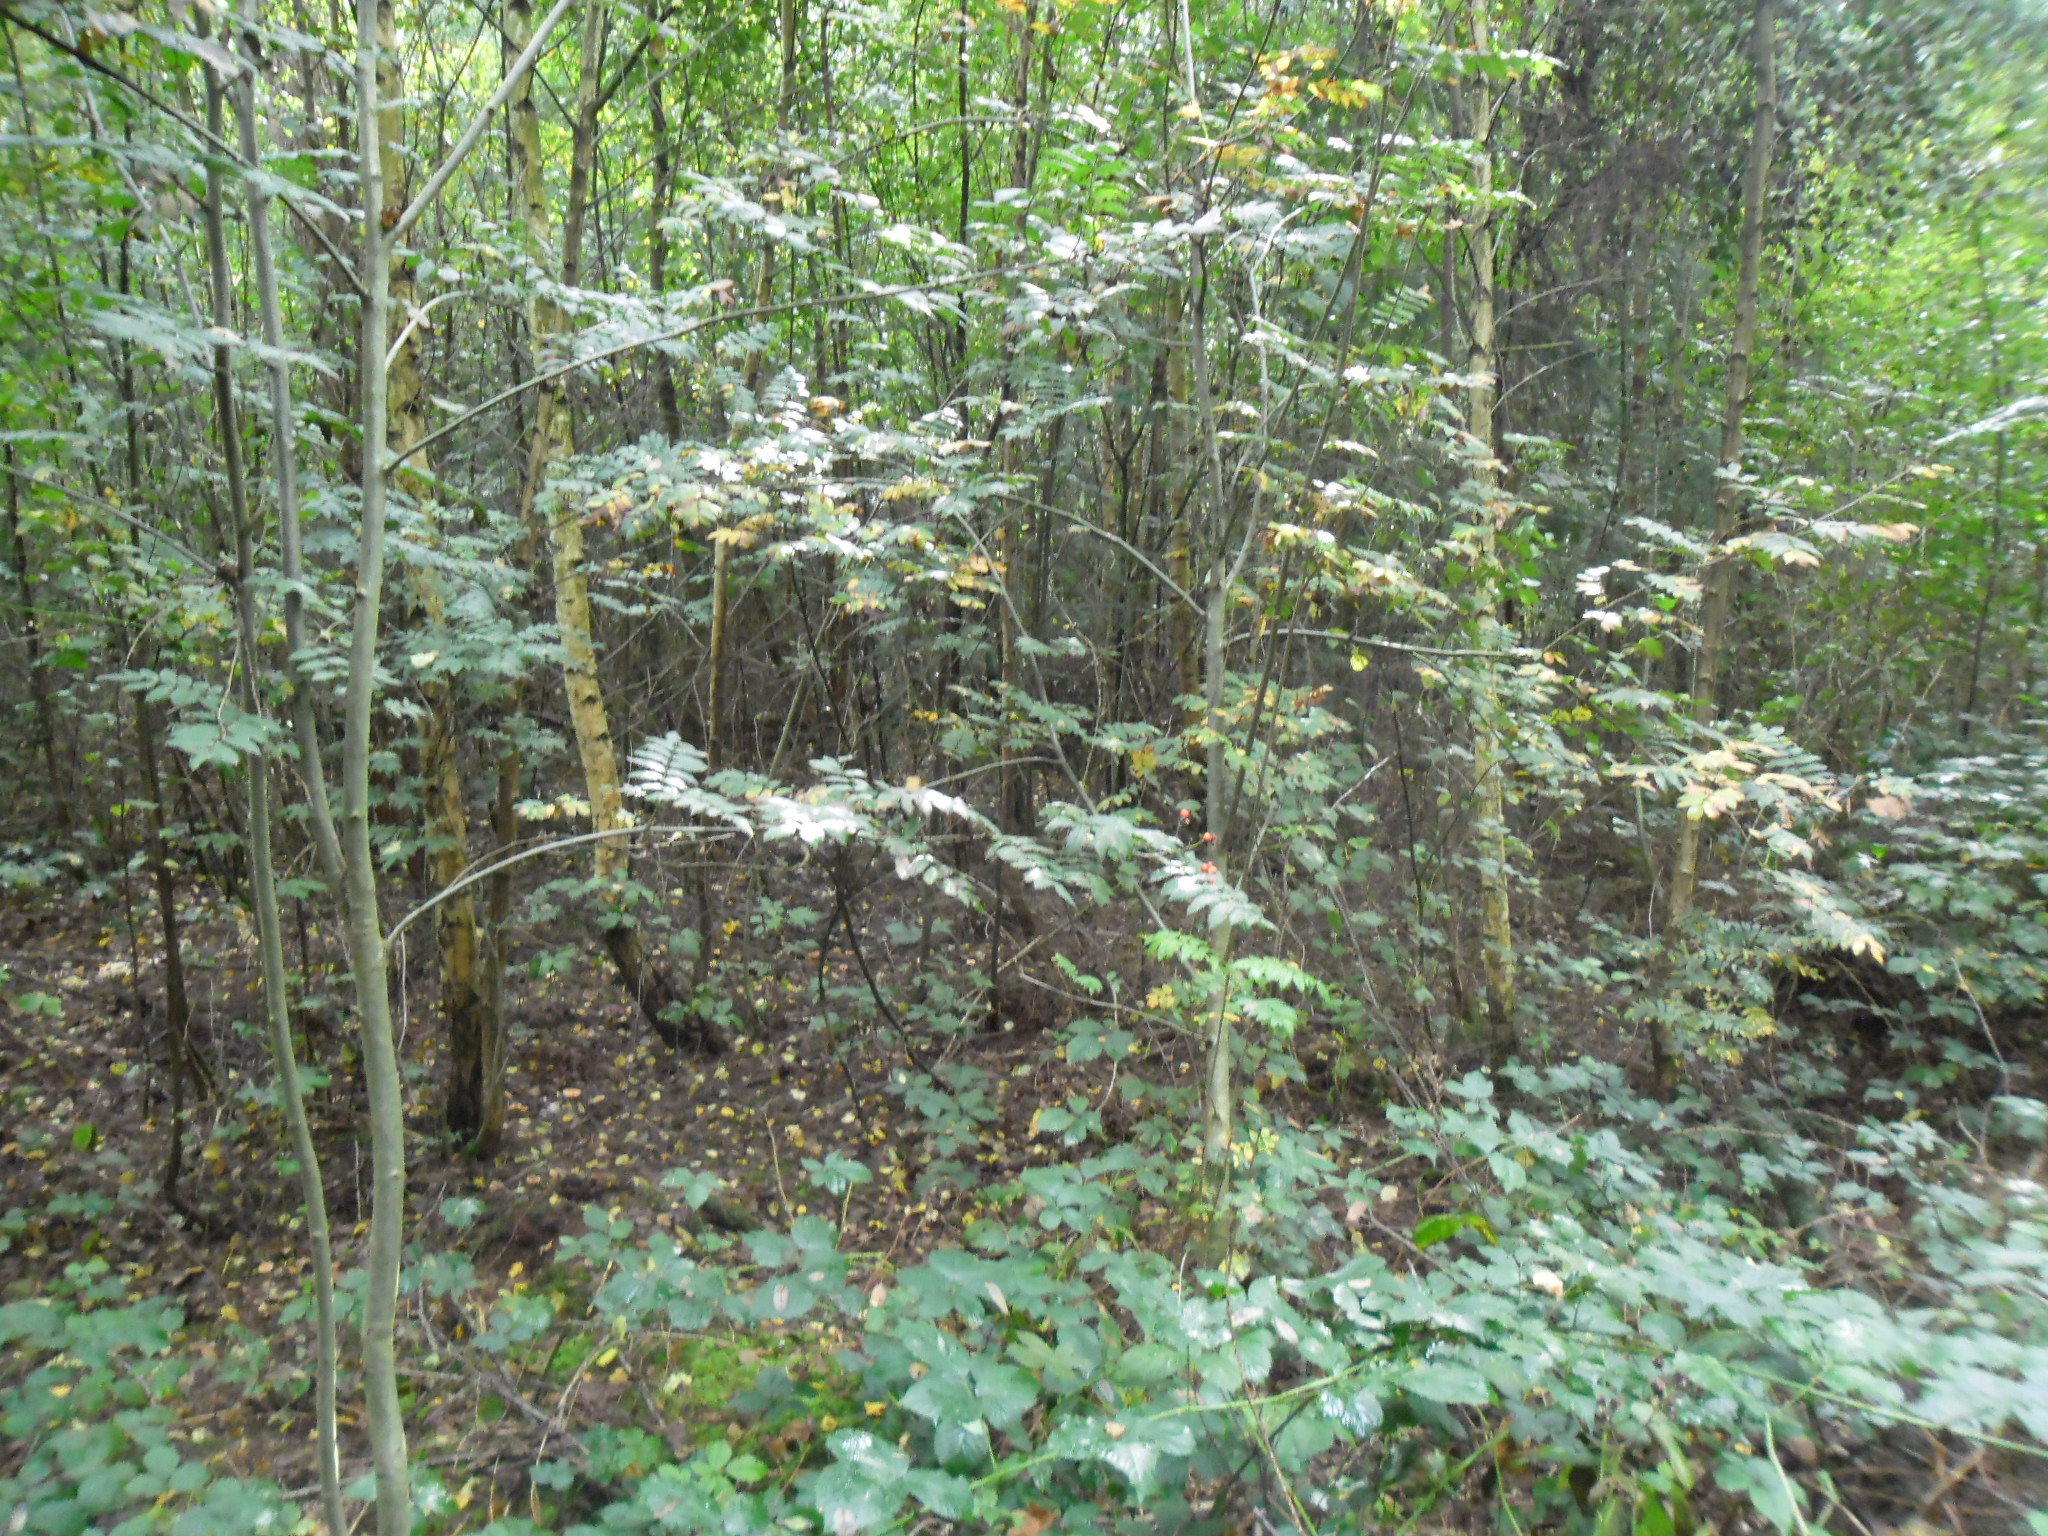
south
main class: Woodland
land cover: Other mixed woodland
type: mesophytic deciduous forest
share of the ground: > 75 %
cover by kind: broadleaved forest trees 60 %, coniferous forest trees 40 %
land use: Amenities, museums, leisure
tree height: > 5 m
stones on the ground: < 10 %
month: September
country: NL
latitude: 52.1296
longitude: 5.4844
